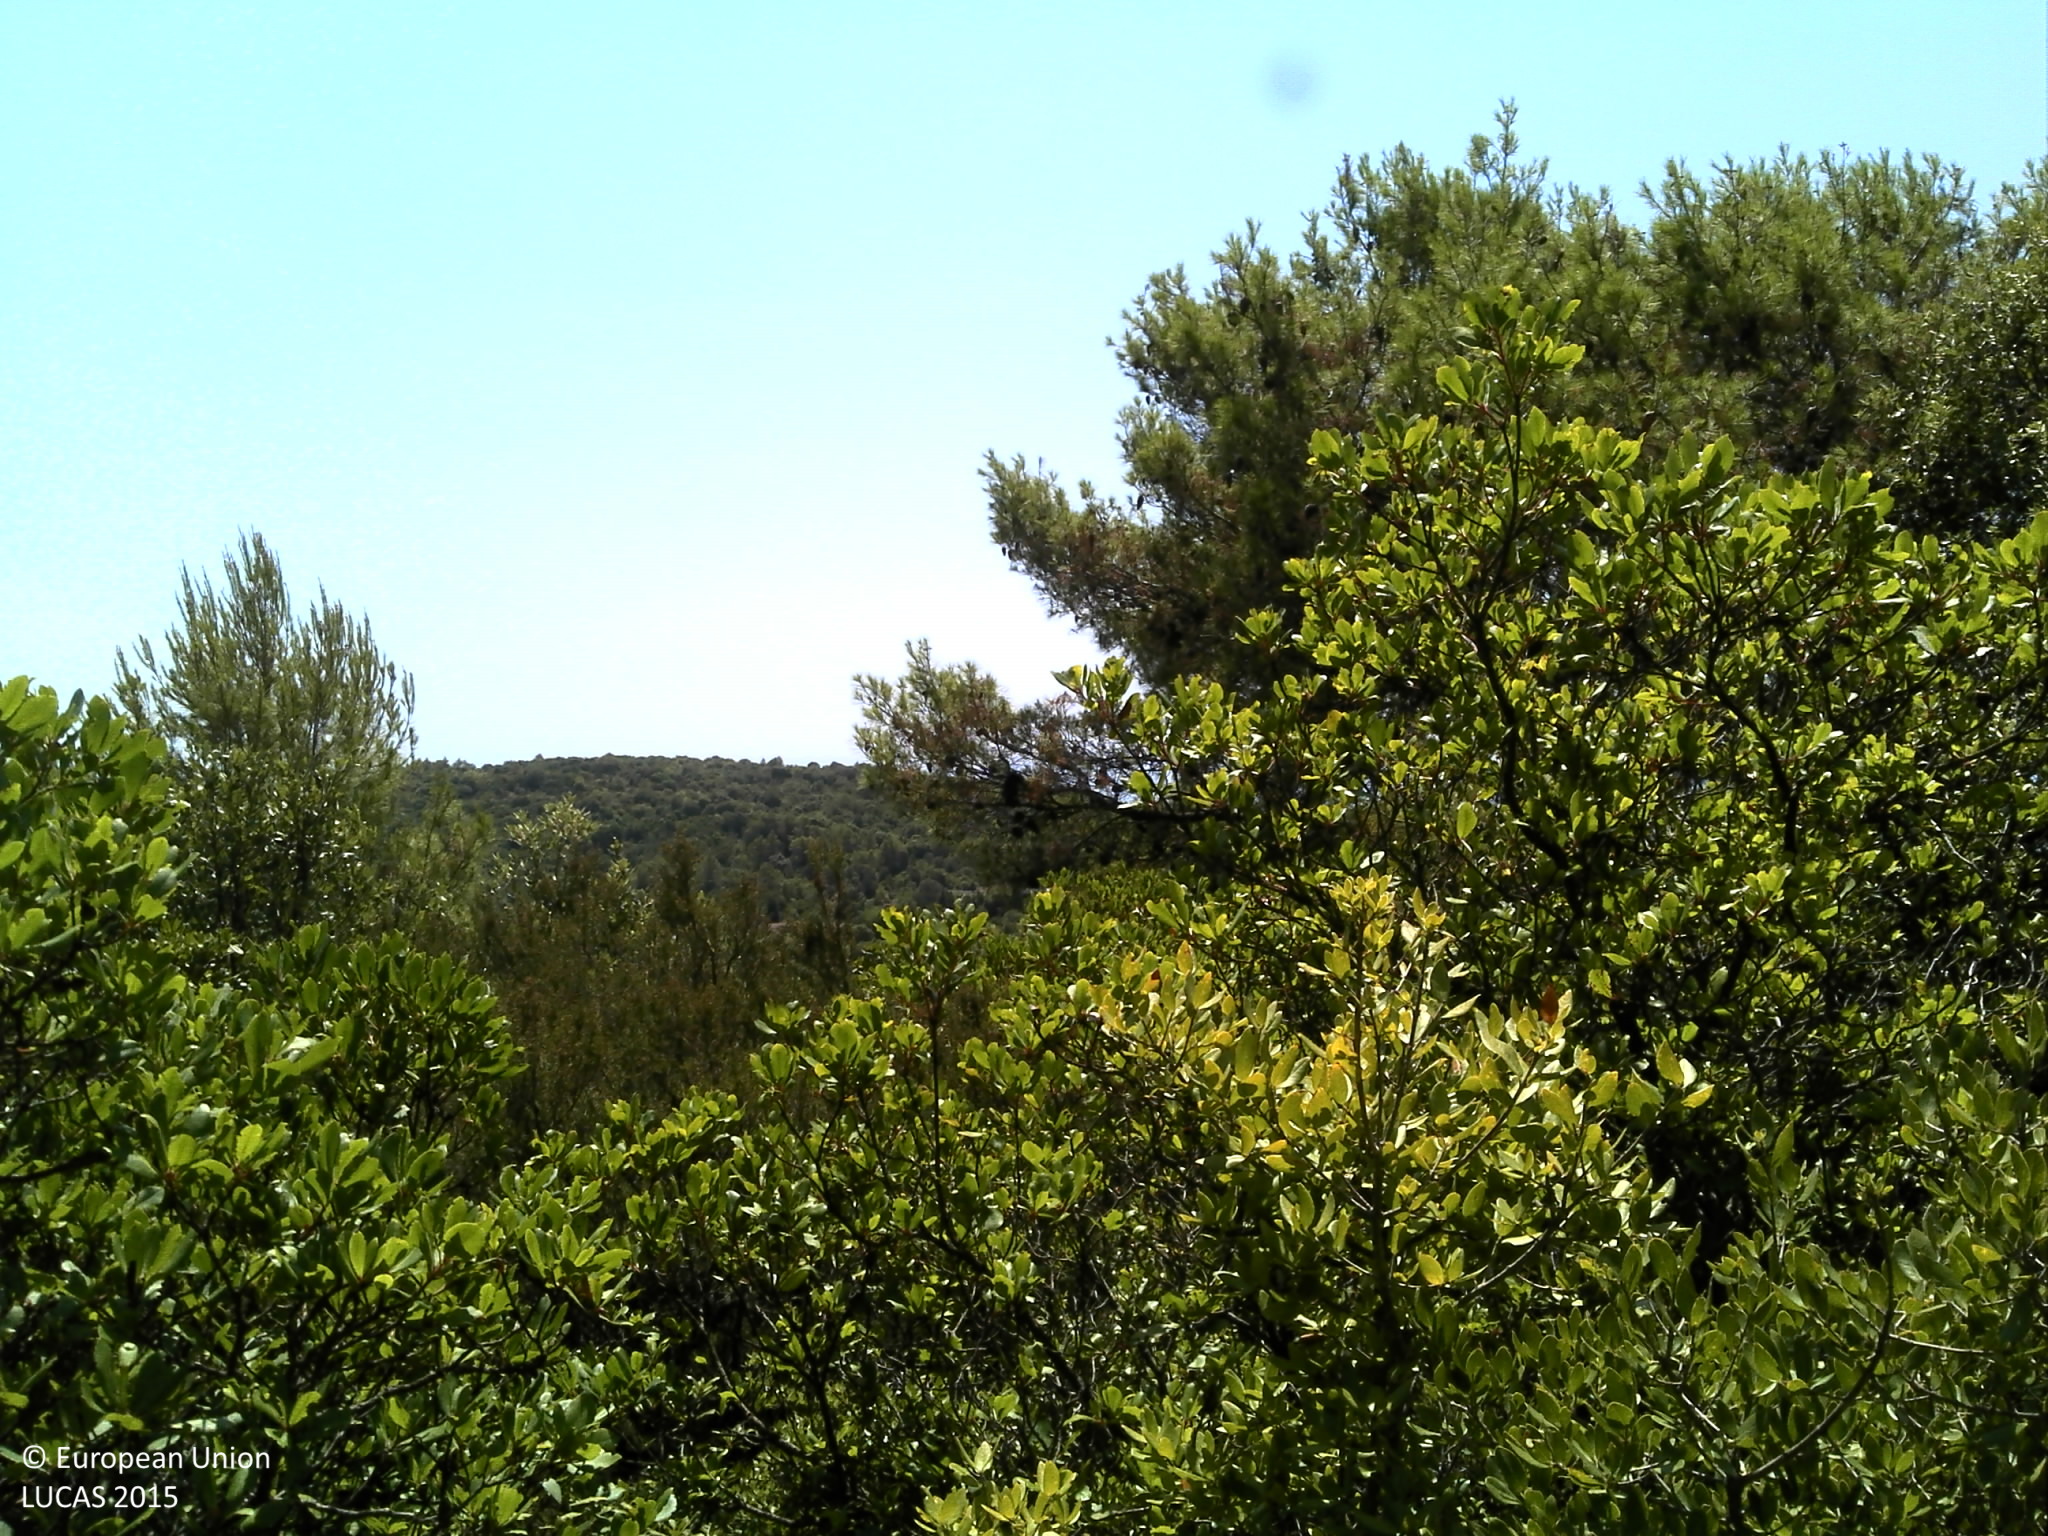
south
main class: Shrubland
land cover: Shrubland with sparse tree cover
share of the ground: > 75 %
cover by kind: shrubs 85 %, coniferous forest trees 5 %, herbaceous plants 5 %, consolidated bare surface 5 %
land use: Semi-natural and natural areas not in use
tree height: > 5 m
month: August
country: HR
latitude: 42.9330
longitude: 17.0594
